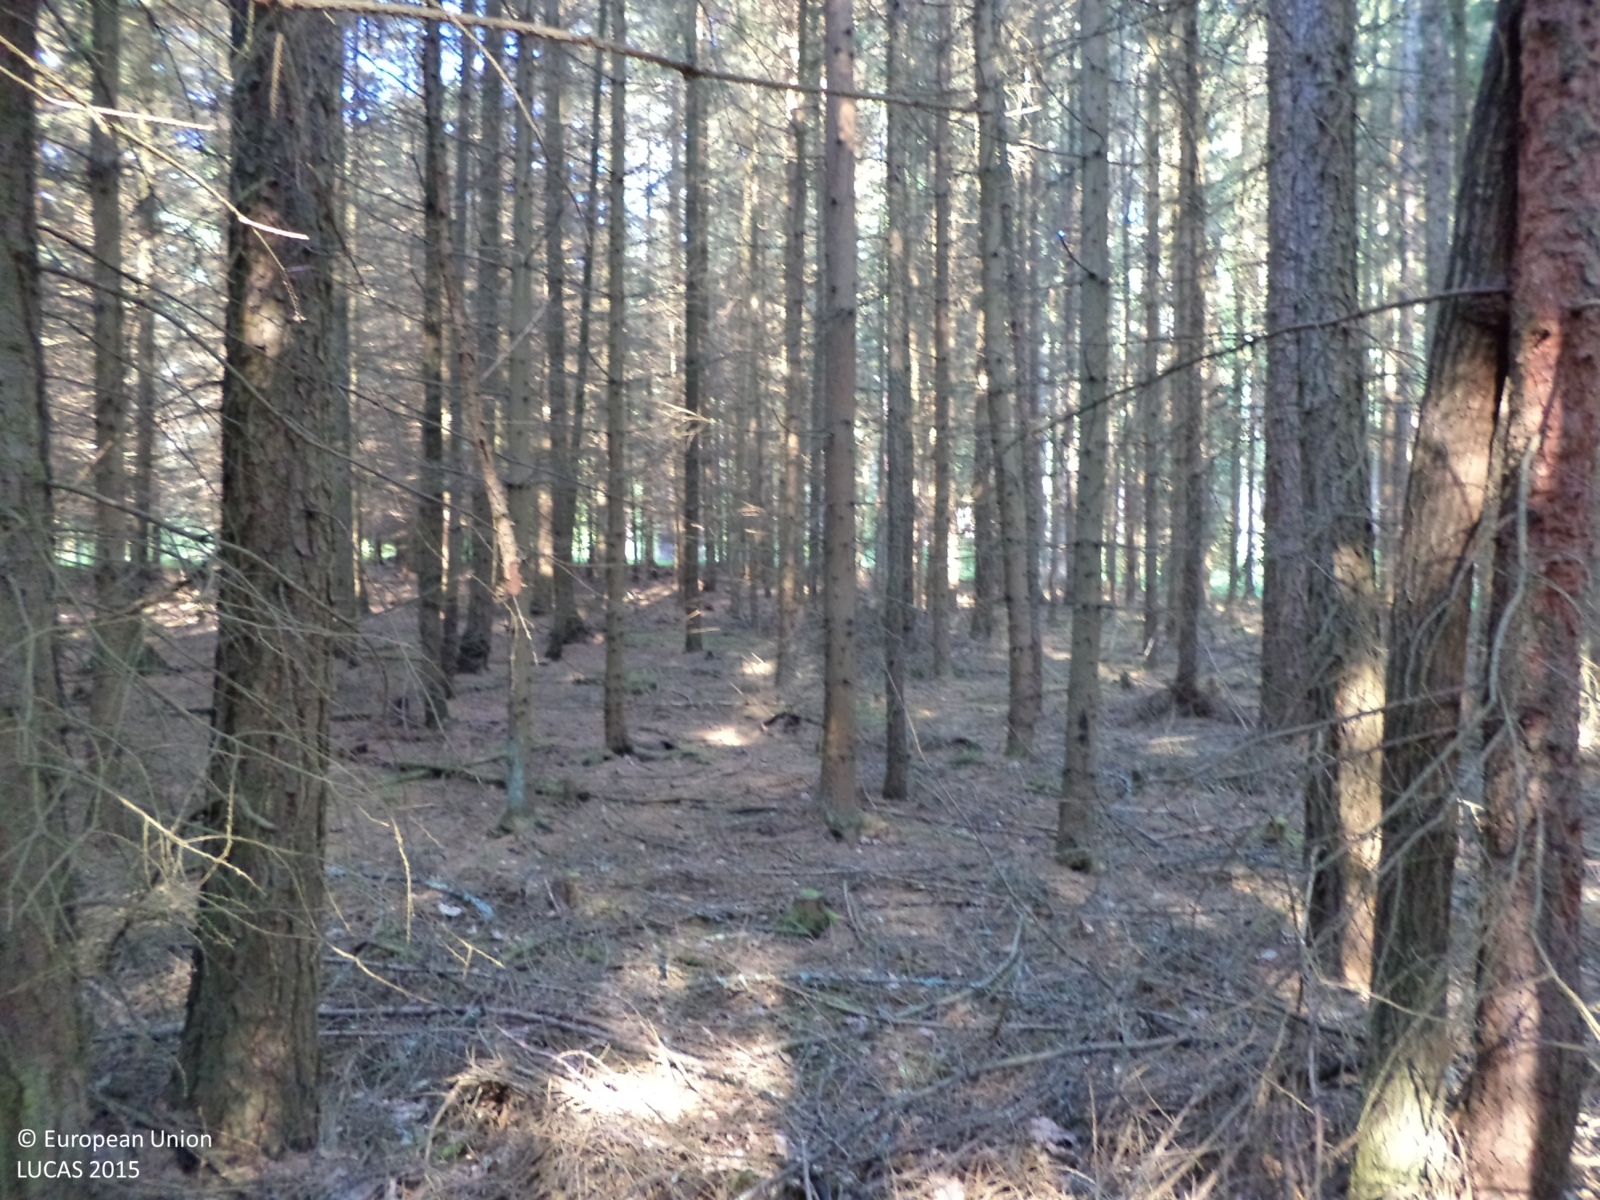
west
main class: Woodland
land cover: Spruce dominated mixed woodland
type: hemiboreal forest and nemoral coniferous forest and mixed broadleaved-coniferous forest
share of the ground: > 75 %
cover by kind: coniferous forest trees 70 %, broadleaved forest trees 25 %, lichens and mosses 5 %
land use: Forestry
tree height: > 5 m
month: June
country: CZ
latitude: 49.2278
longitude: 14.5741
